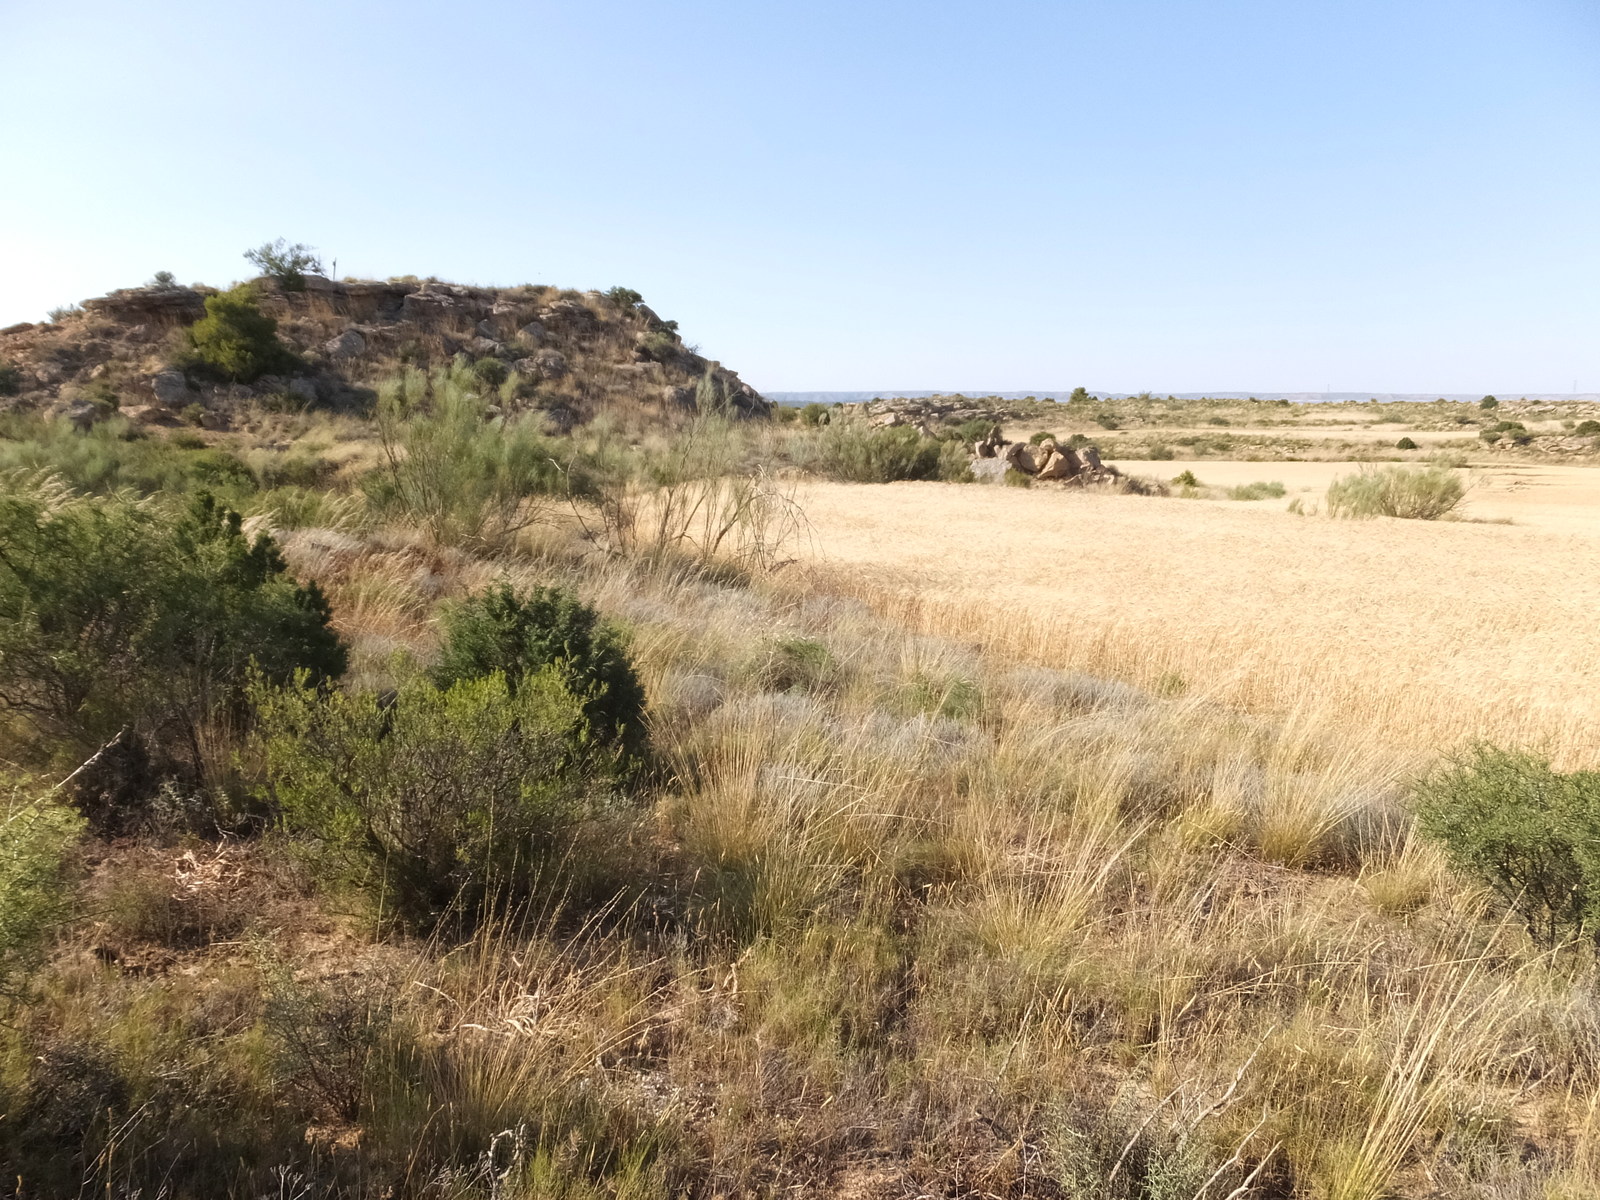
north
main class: Shrubland
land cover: Shrubland without tree cover
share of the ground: > 75 %
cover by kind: shrubs 50 %, herbaceous plants 50 %
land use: Semi-natural and natural areas not in use
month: June
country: ES
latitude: 41.2087
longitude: -0.2101
